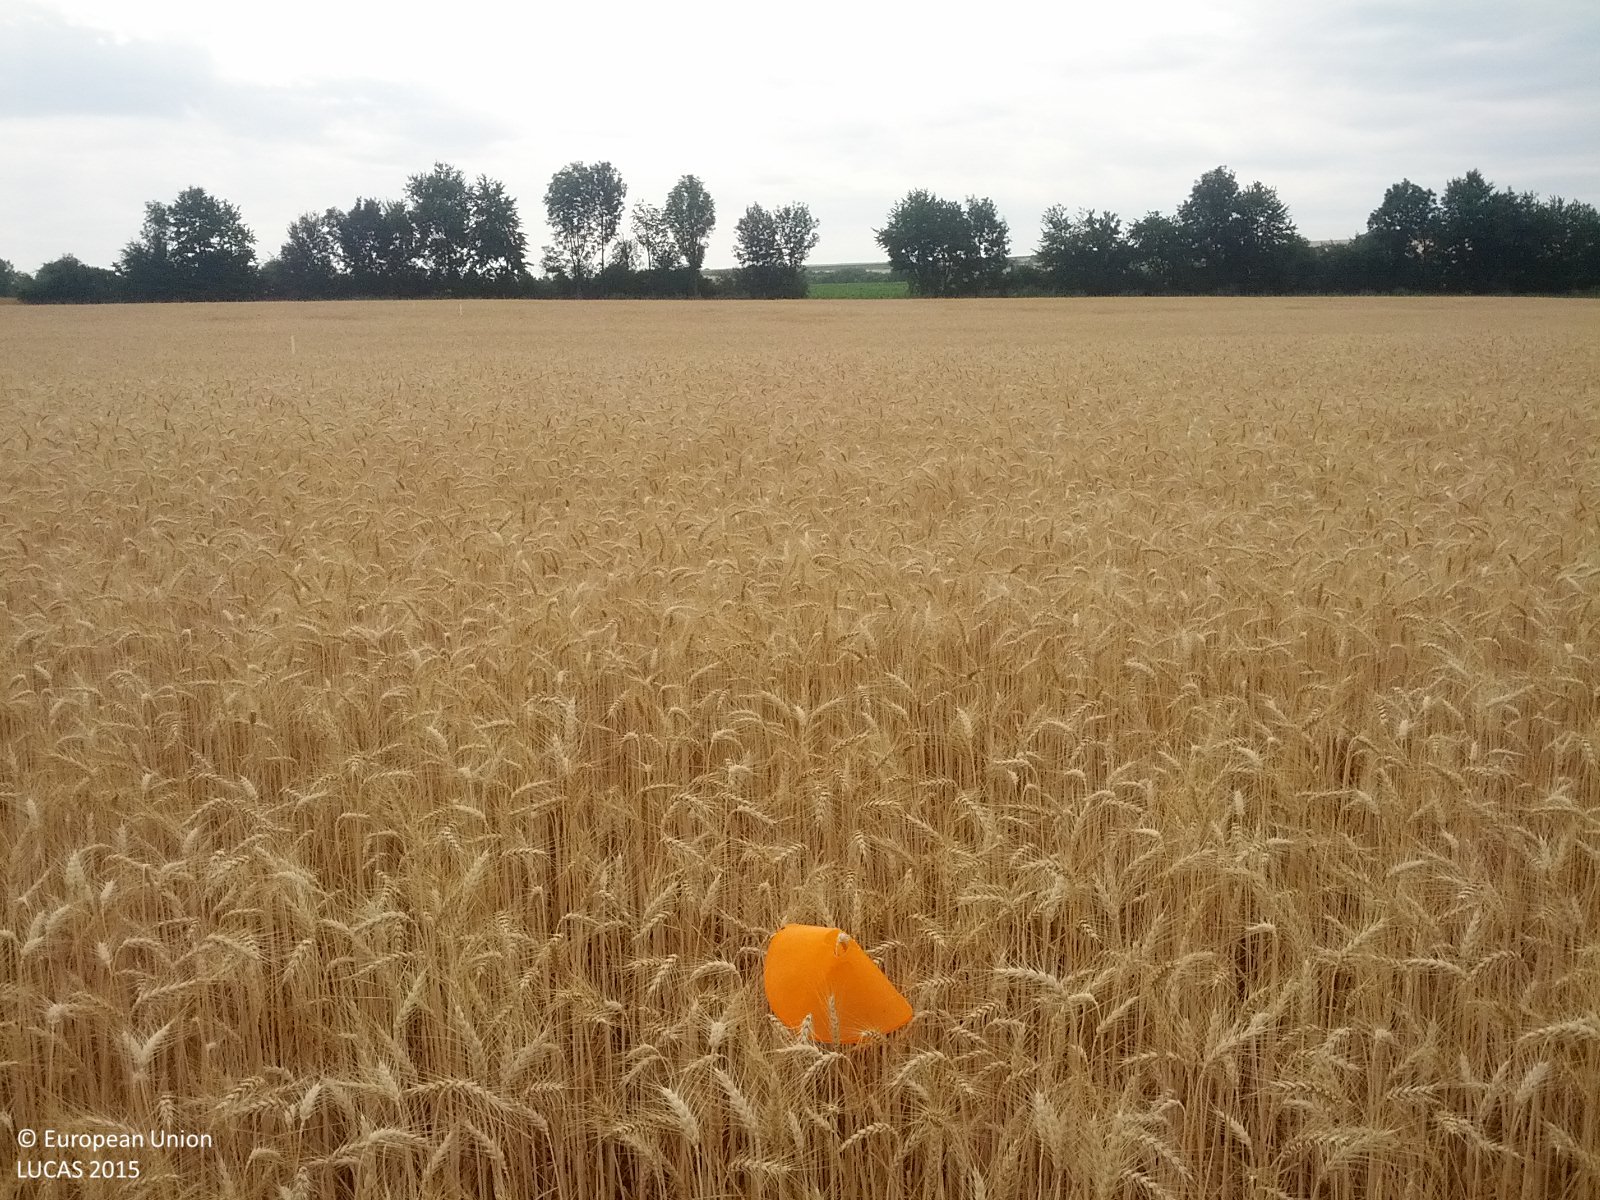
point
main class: Cropland
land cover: Common wheat
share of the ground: > 75 %
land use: Agriculture (excluding fallow land and kitchen gardens)
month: July
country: AT
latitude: 48.7818
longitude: 16.6348
